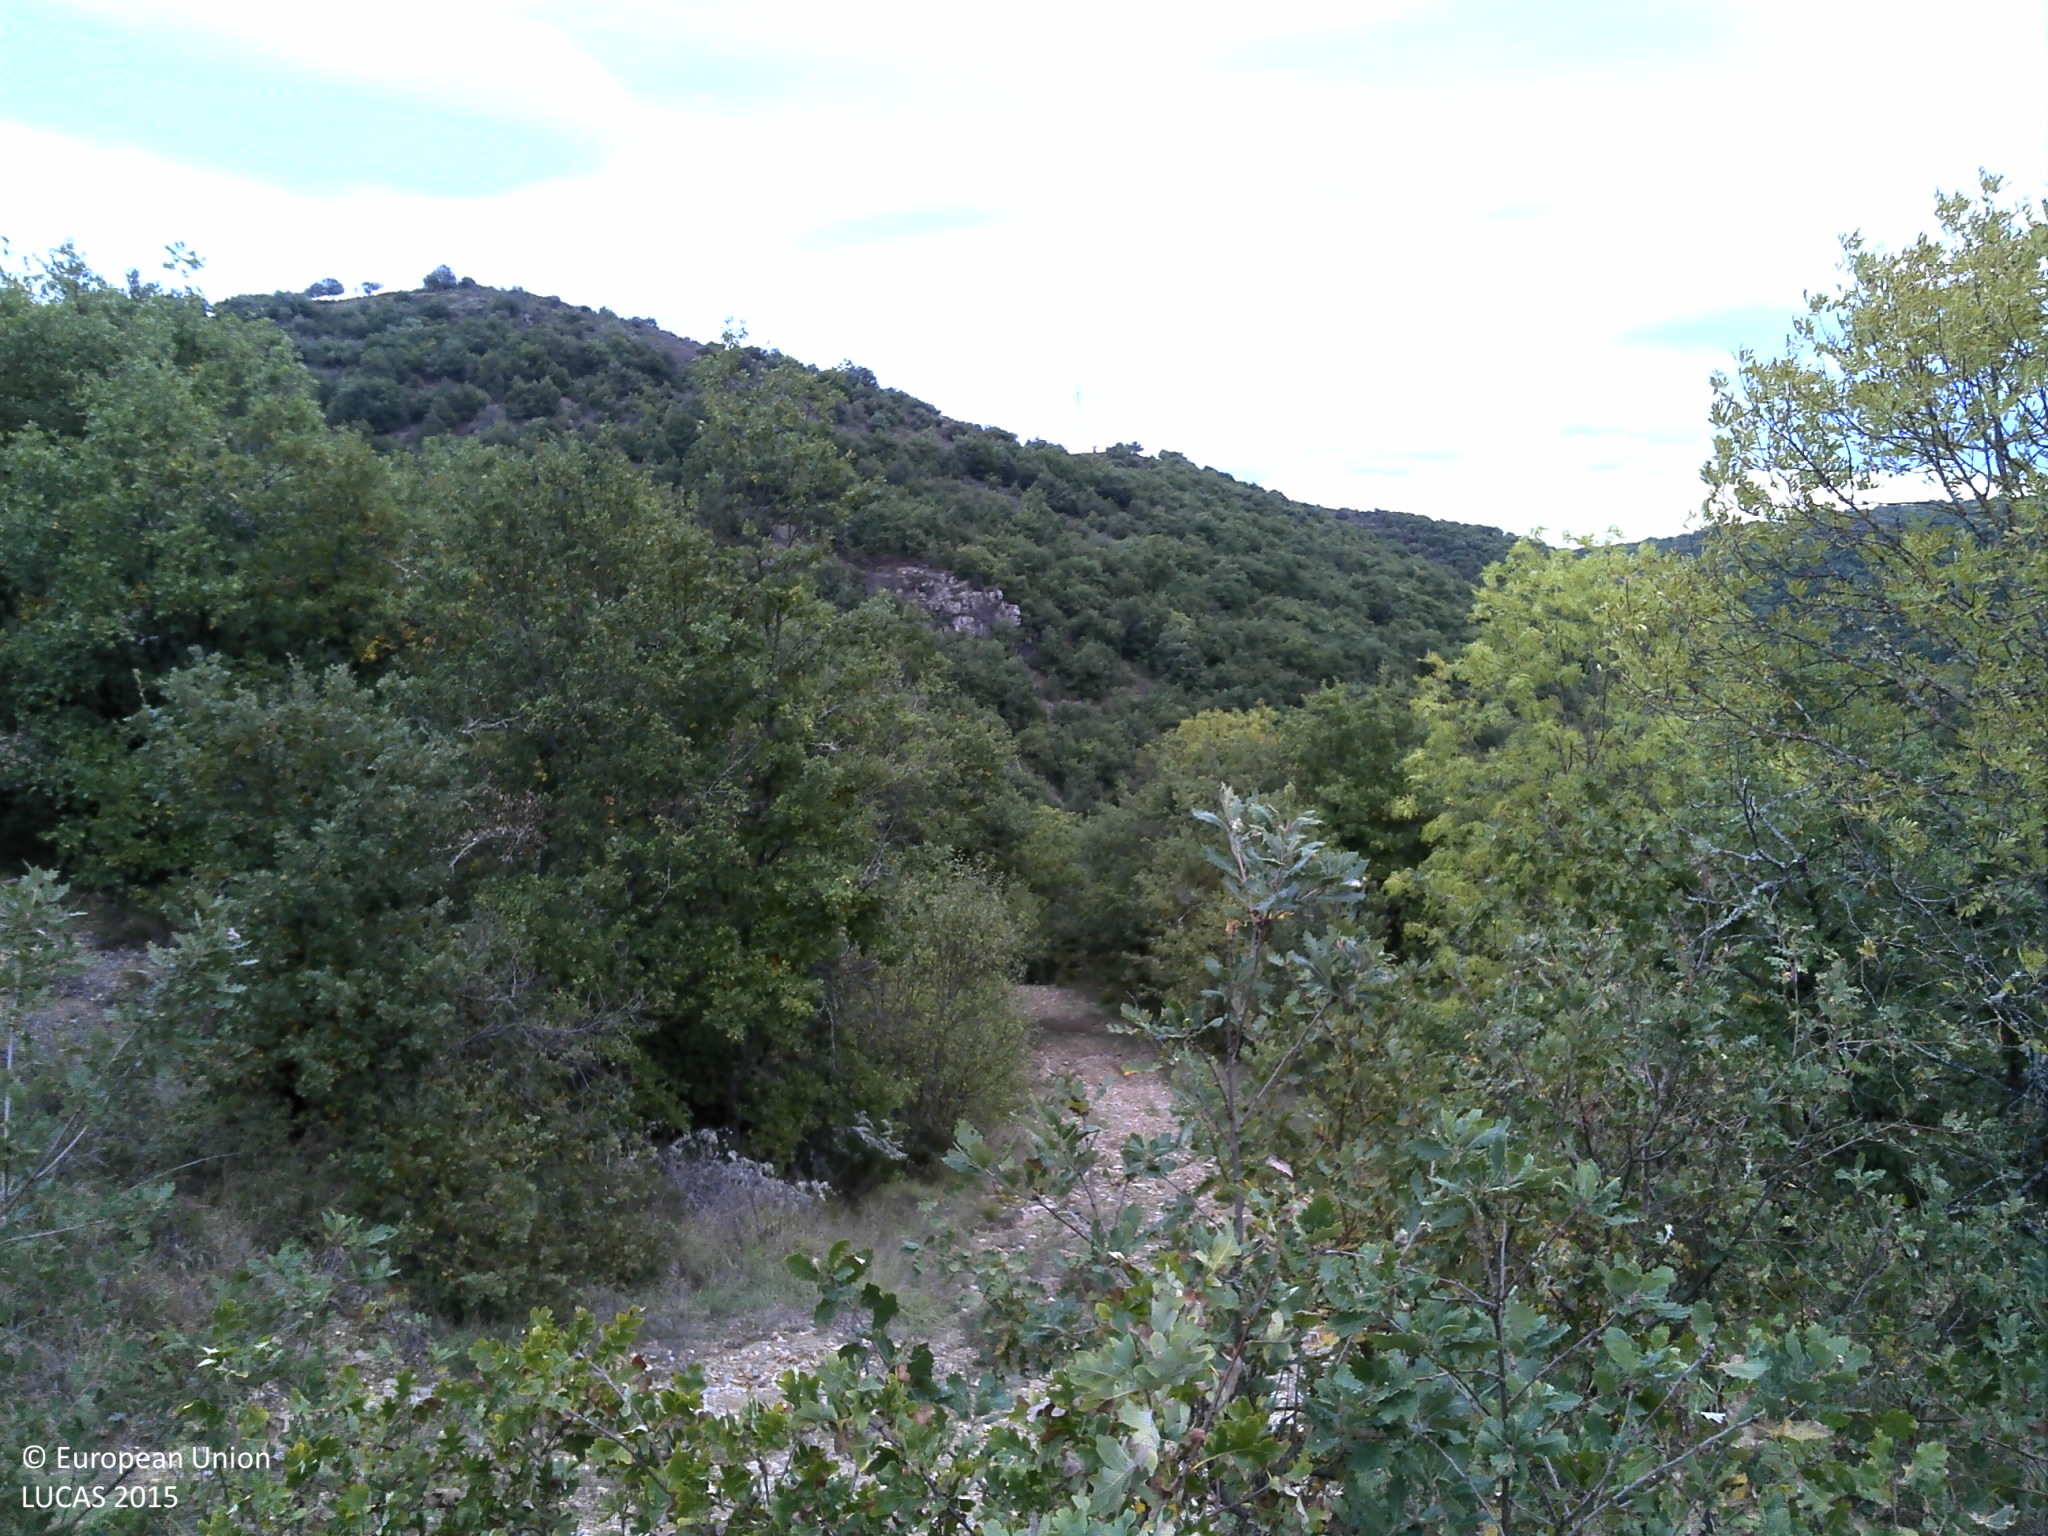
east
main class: Shrubland
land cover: Shrubland with sparse tree cover
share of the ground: > 75 %
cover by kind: shrubs 85 %, herbaceous plants 10 %, broadleaved forest trees 5 %
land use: Semi-natural and natural areas not in use
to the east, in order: Shrubland with sparse tree cover; Broadleaved woodland; Tracks; Grass margins; Fences; Broadleaved woodland; Grassland without tree/shrub cover; Broadleaved woodland
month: October
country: FR
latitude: 45.3556
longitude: 3.1721
